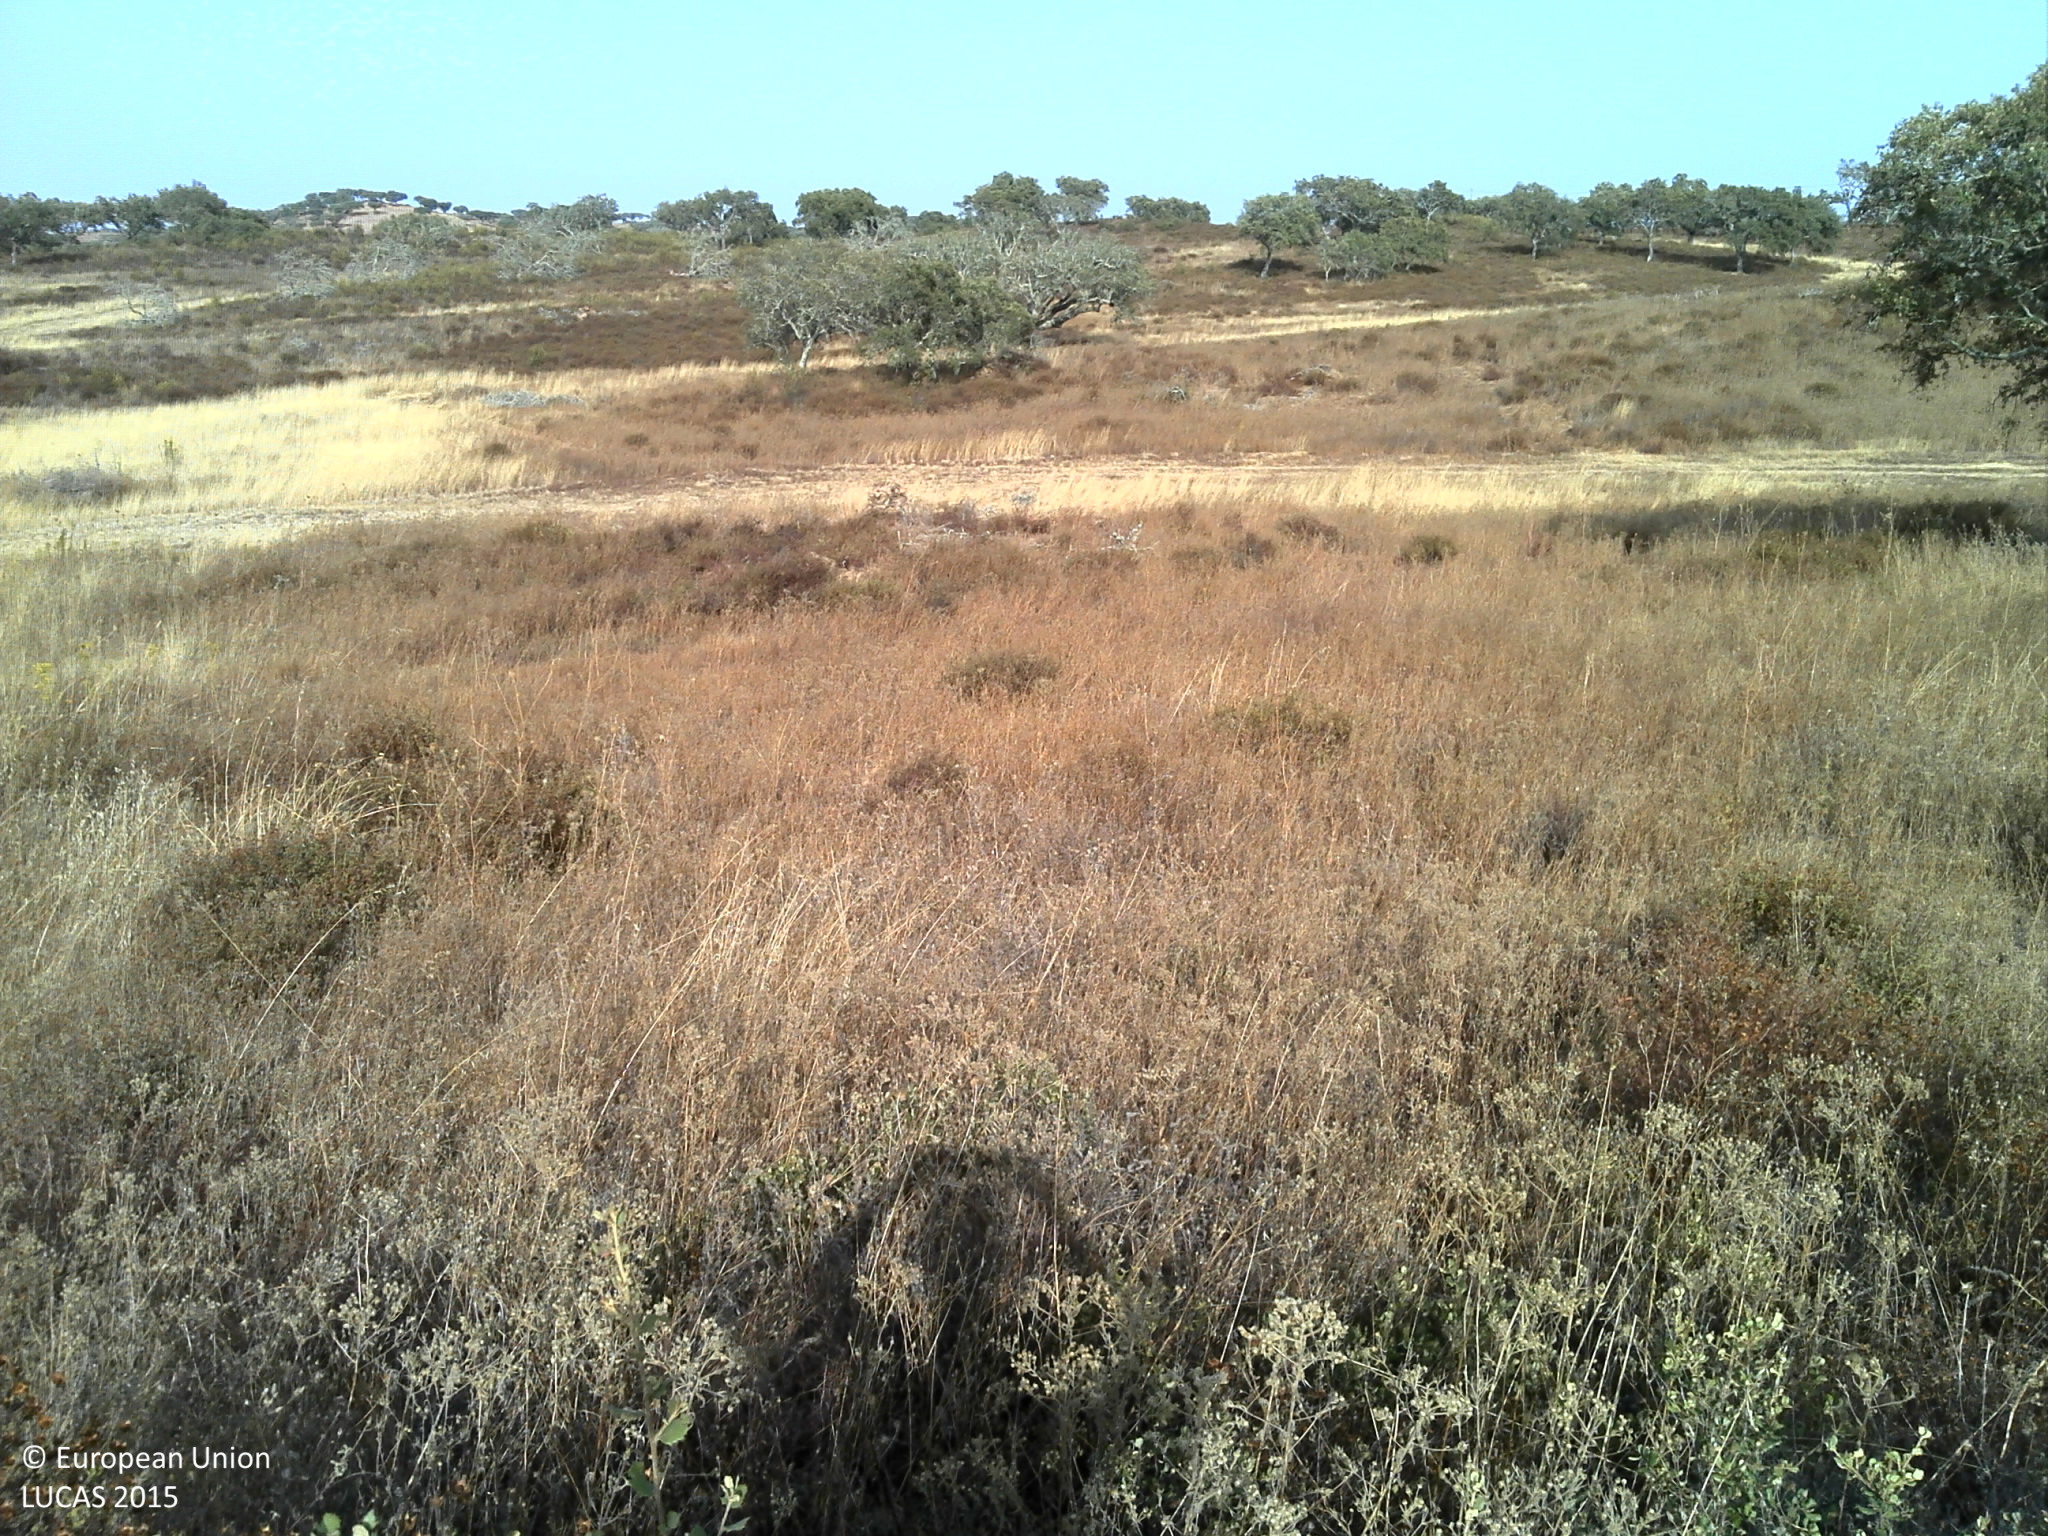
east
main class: Grassland
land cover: Grassland with sparse tree/shrub cover
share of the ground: > 75 %
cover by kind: herbaceous plants 80 %, consolidated bare surface 15 %, broadleaved forest trees 5 %
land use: Agriculture (excluding fallow land and kitchen gardens)
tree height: > 5 m
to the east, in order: Grassland with sparse tree/shrub cover; Grassland without tree/shrub cover; Tracks; Grassland without tree/shrub cover; Tracks; Grassland without tree/shrub cover; Shrubland without tree cover
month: July
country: PT
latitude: 37.6302
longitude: -8.2613
